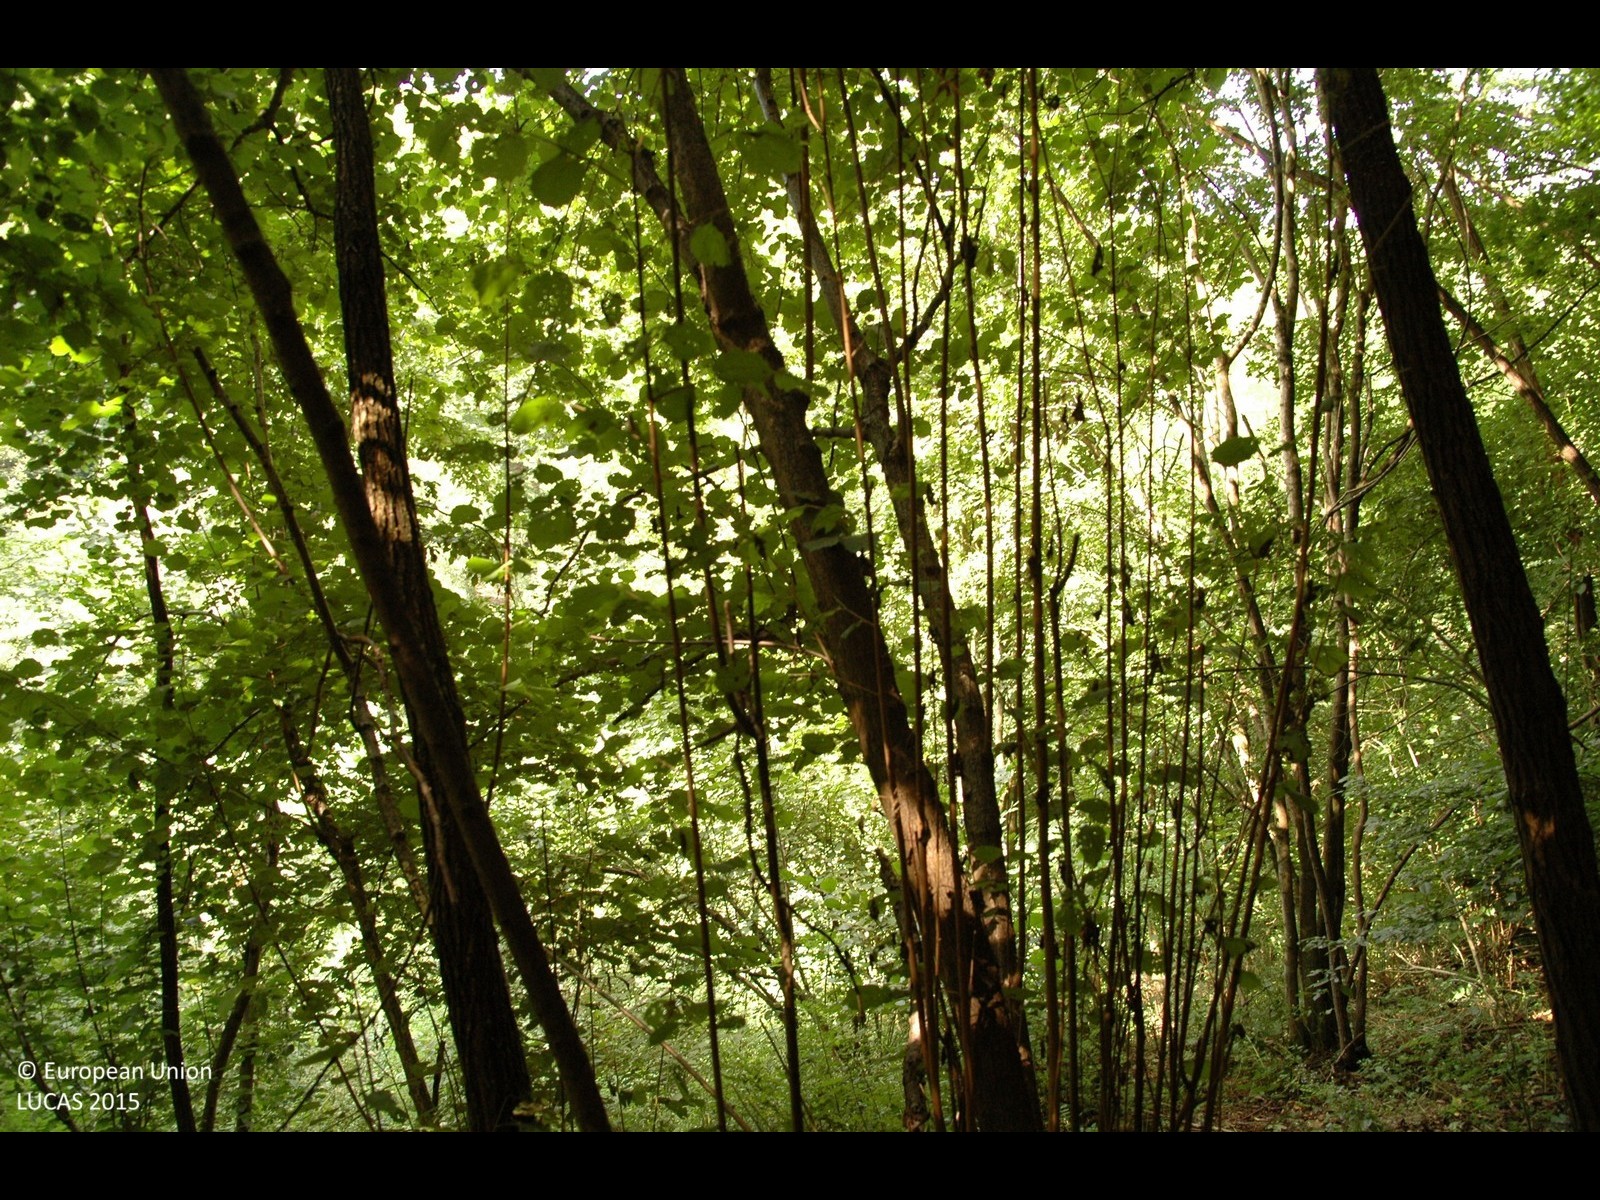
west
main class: Woodland
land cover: Broadleaved woodland
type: mesophytic deciduous forest
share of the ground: > 75 %
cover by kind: broadleaved forest trees 100 %
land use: Forestry
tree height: > 5 m
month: August
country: HR
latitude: 45.9408
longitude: 16.1255
